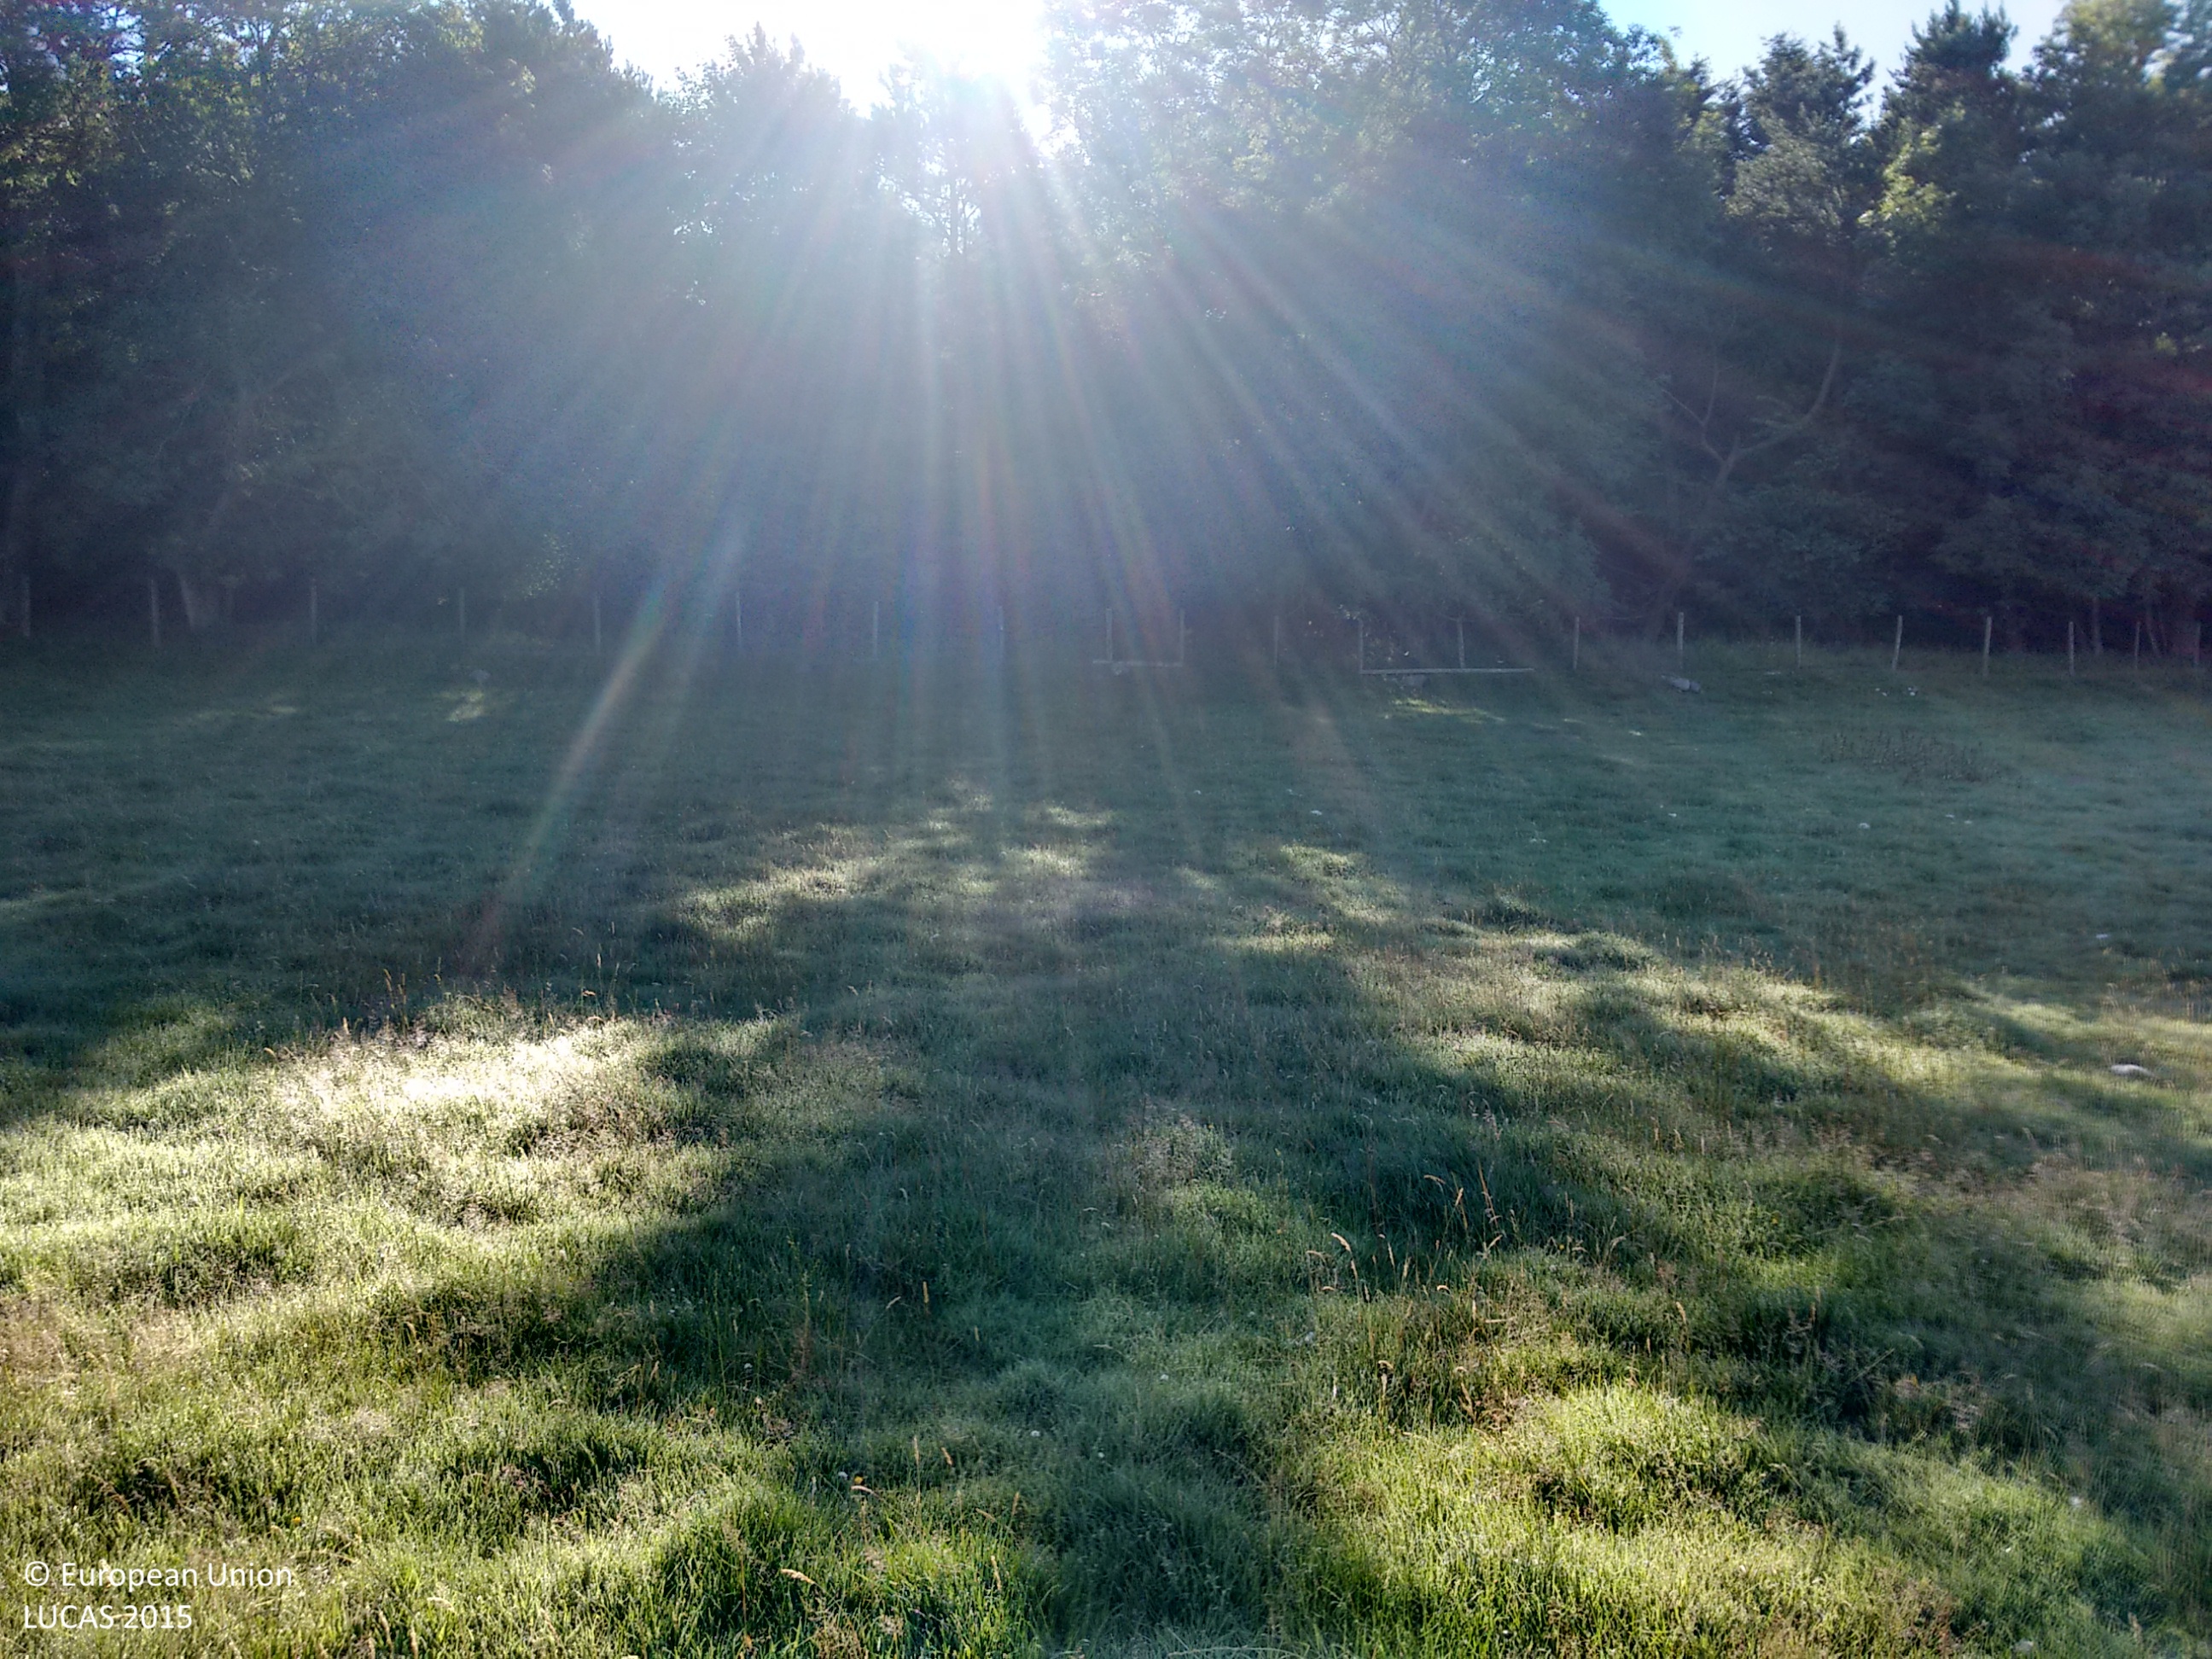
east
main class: Grassland
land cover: Grassland without tree/shrub cover
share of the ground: > 75 %
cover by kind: herbaceous plants 100 %
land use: Agriculture (excluding fallow land and kitchen gardens)
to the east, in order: Grassland without tree/shrub cover; Fences; Pine dominated mixed woodland; Fences; Grassland without tree/shrub cover
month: August
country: GB
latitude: 54.6302
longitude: -2.8178
